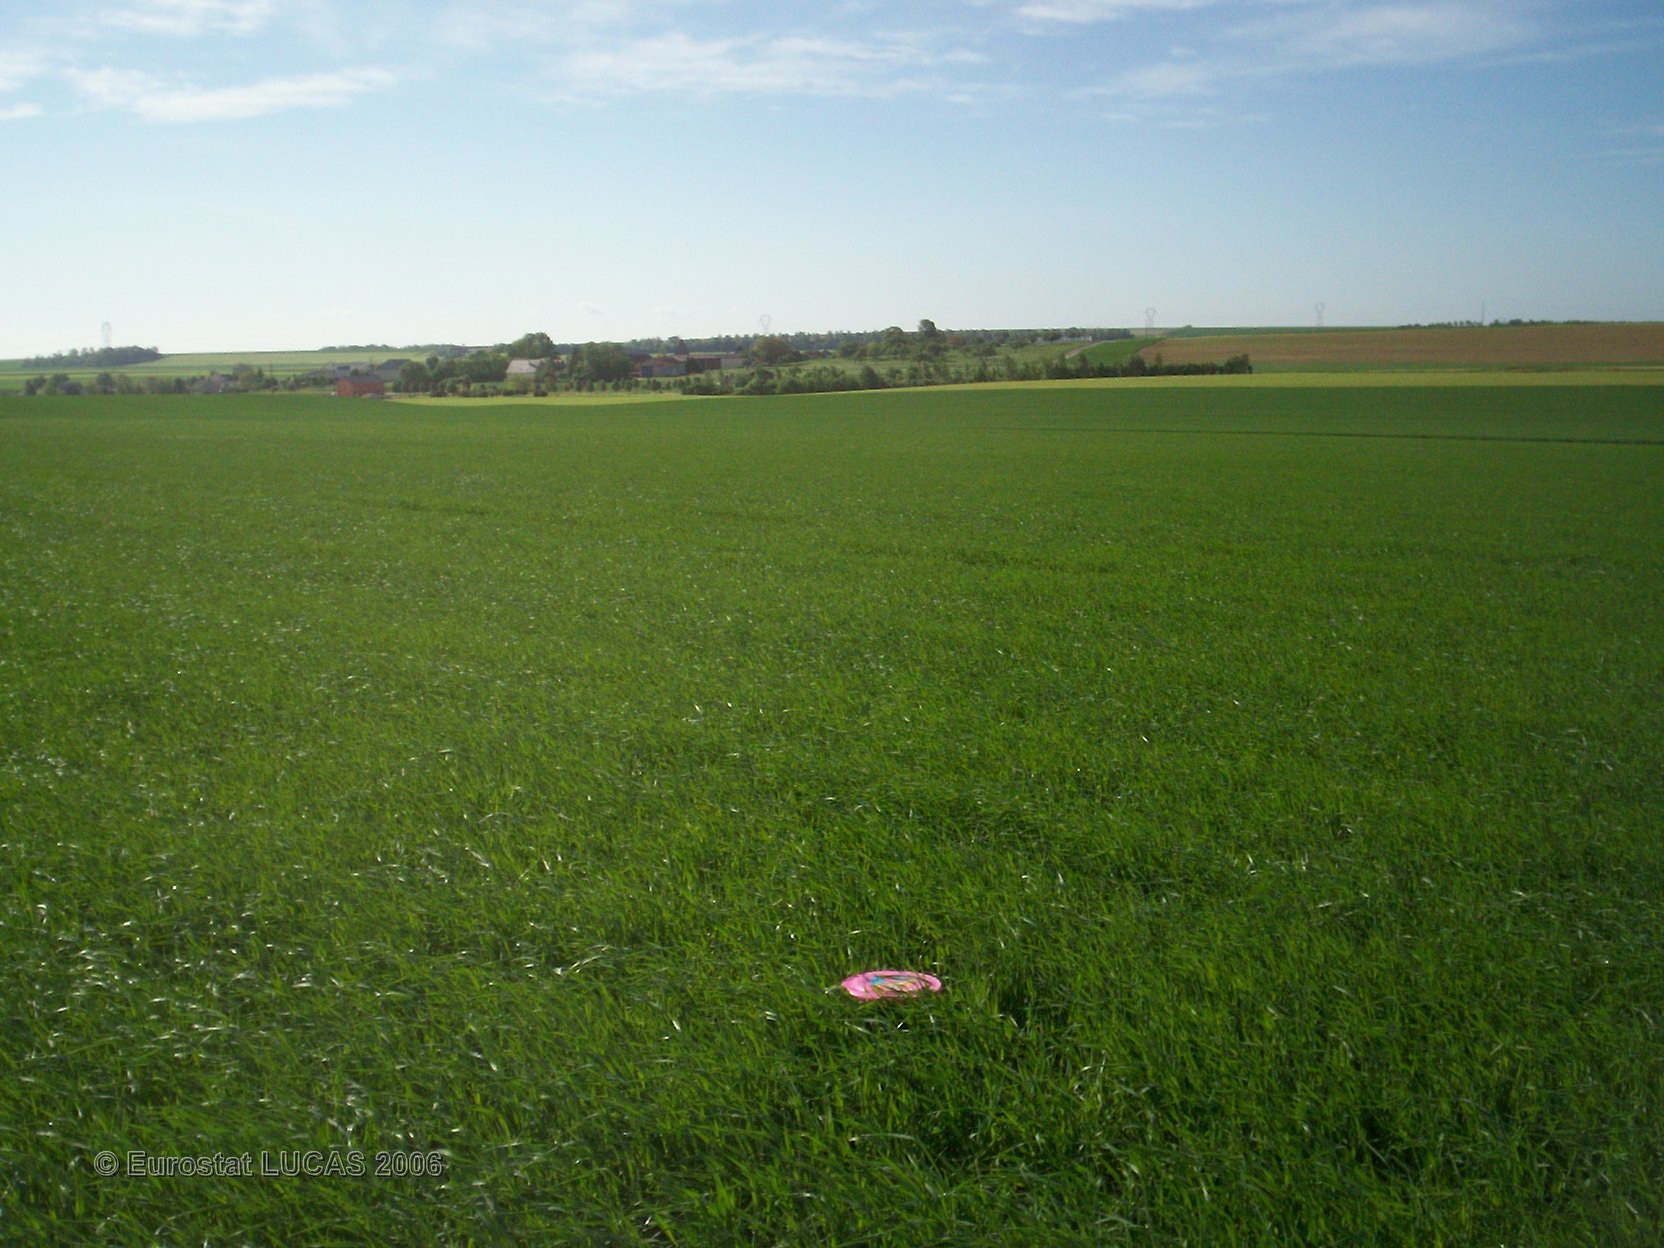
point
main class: Cropland
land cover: Barley
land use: Agriculture (excluding fallow land and kitchen gardens)
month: May
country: FR
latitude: 49.4343
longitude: 4.4113
